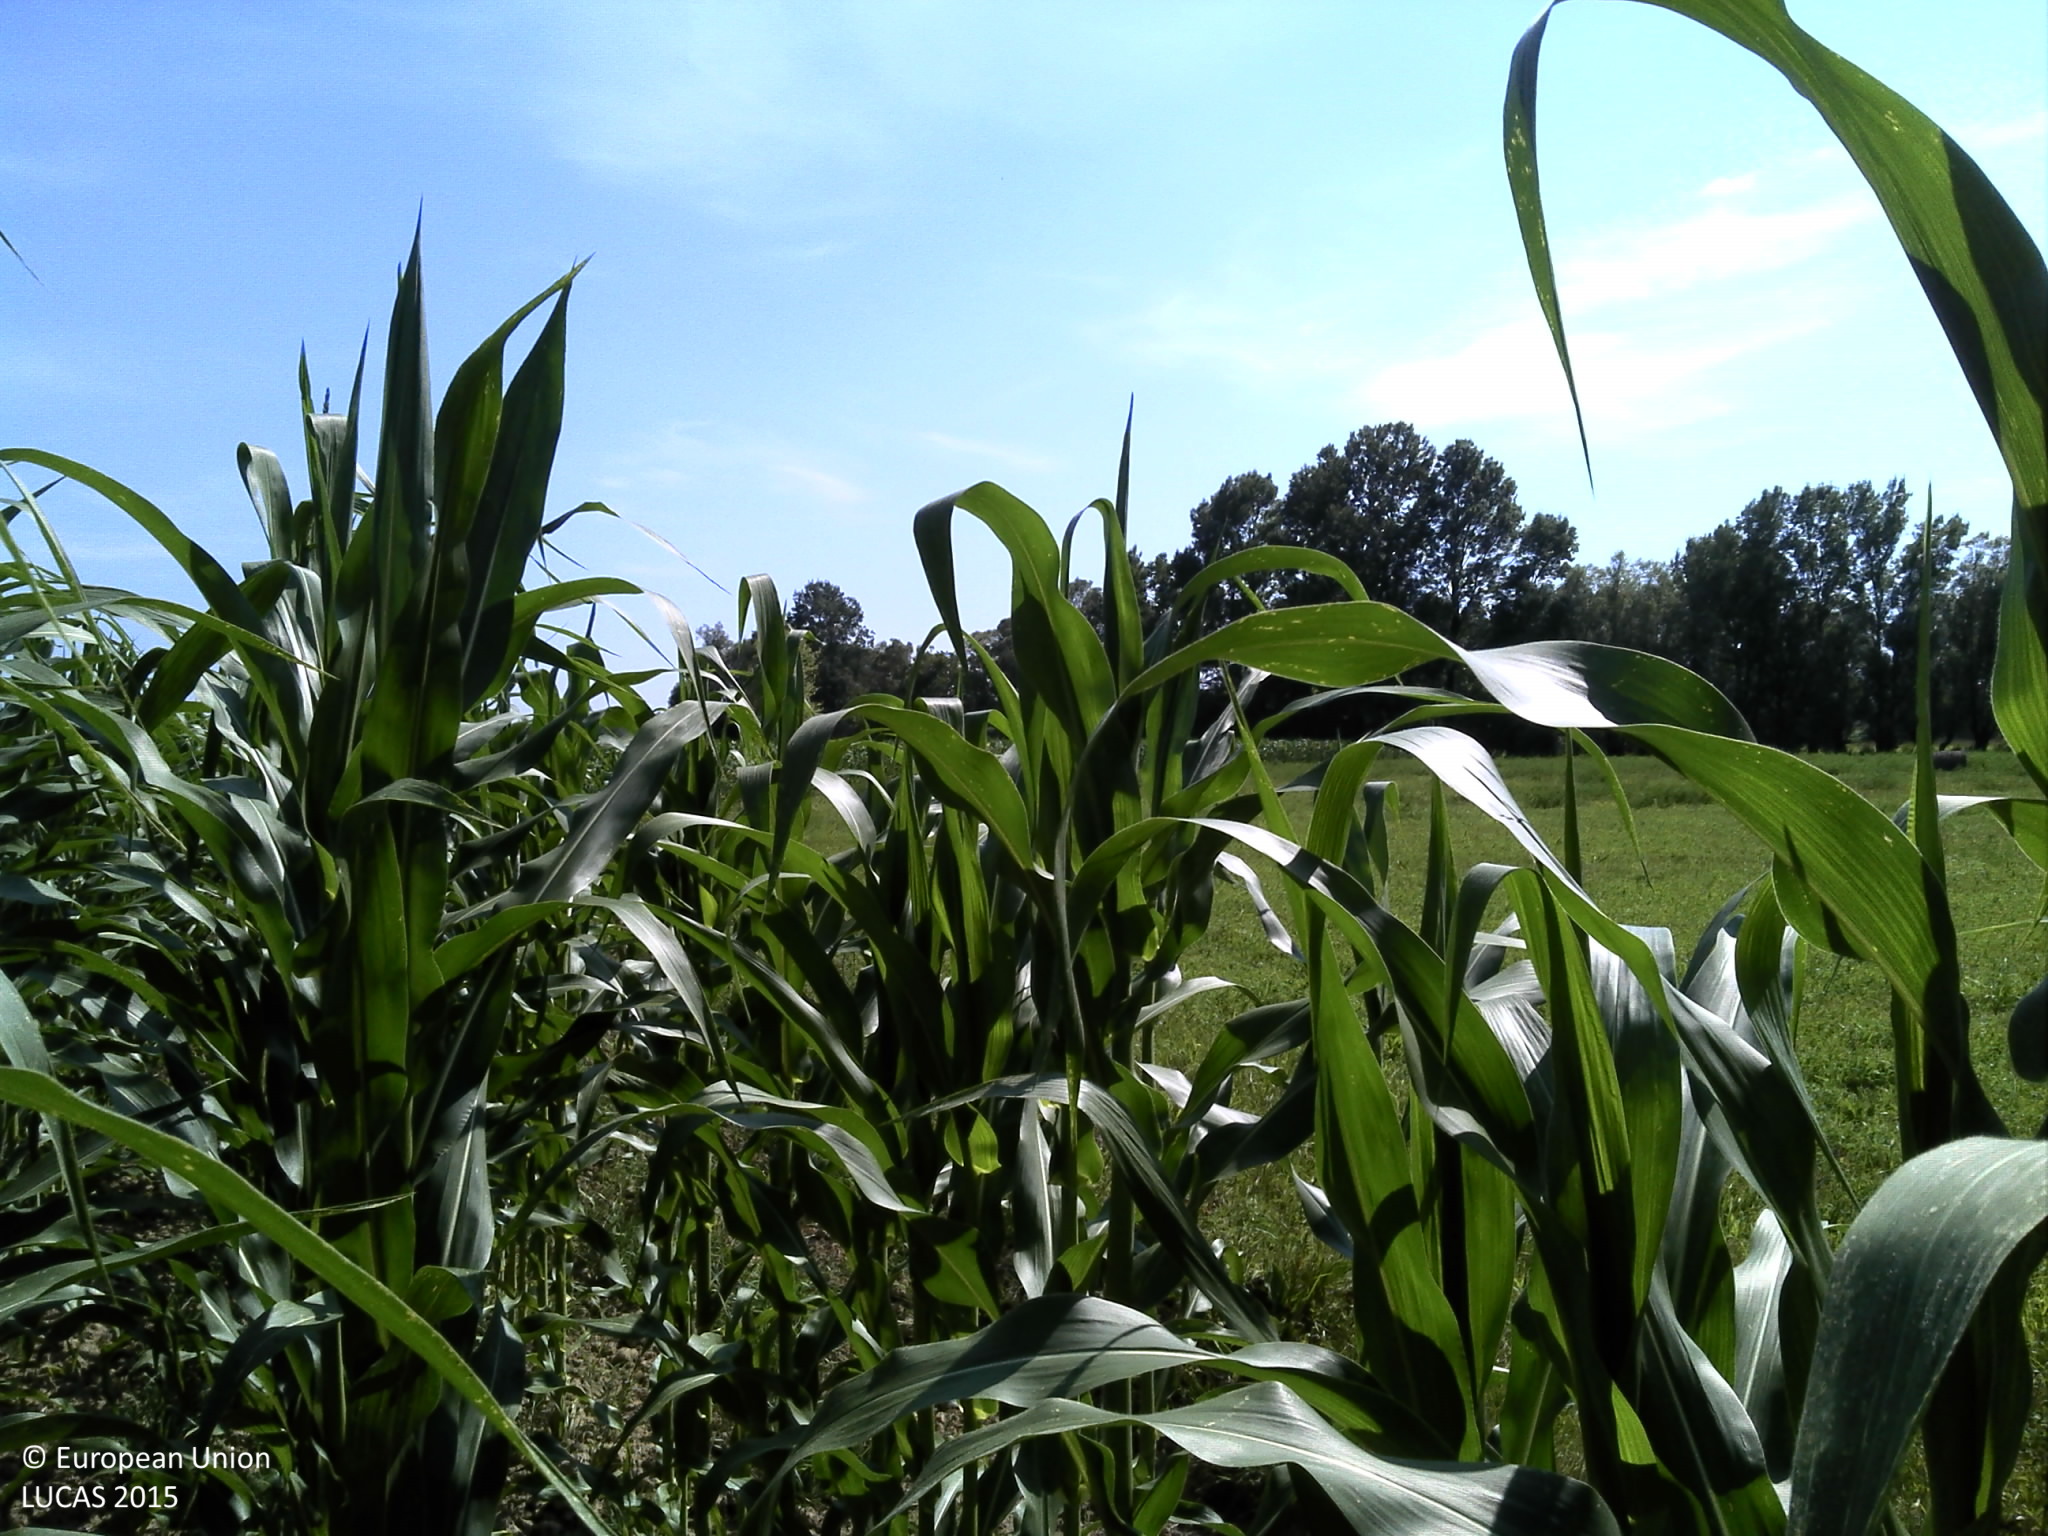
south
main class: Cropland
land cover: Maize
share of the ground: > 75 %
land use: Agriculture (excluding fallow land and kitchen gardens)
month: August
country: HR
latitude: 45.3849
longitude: 16.6522
